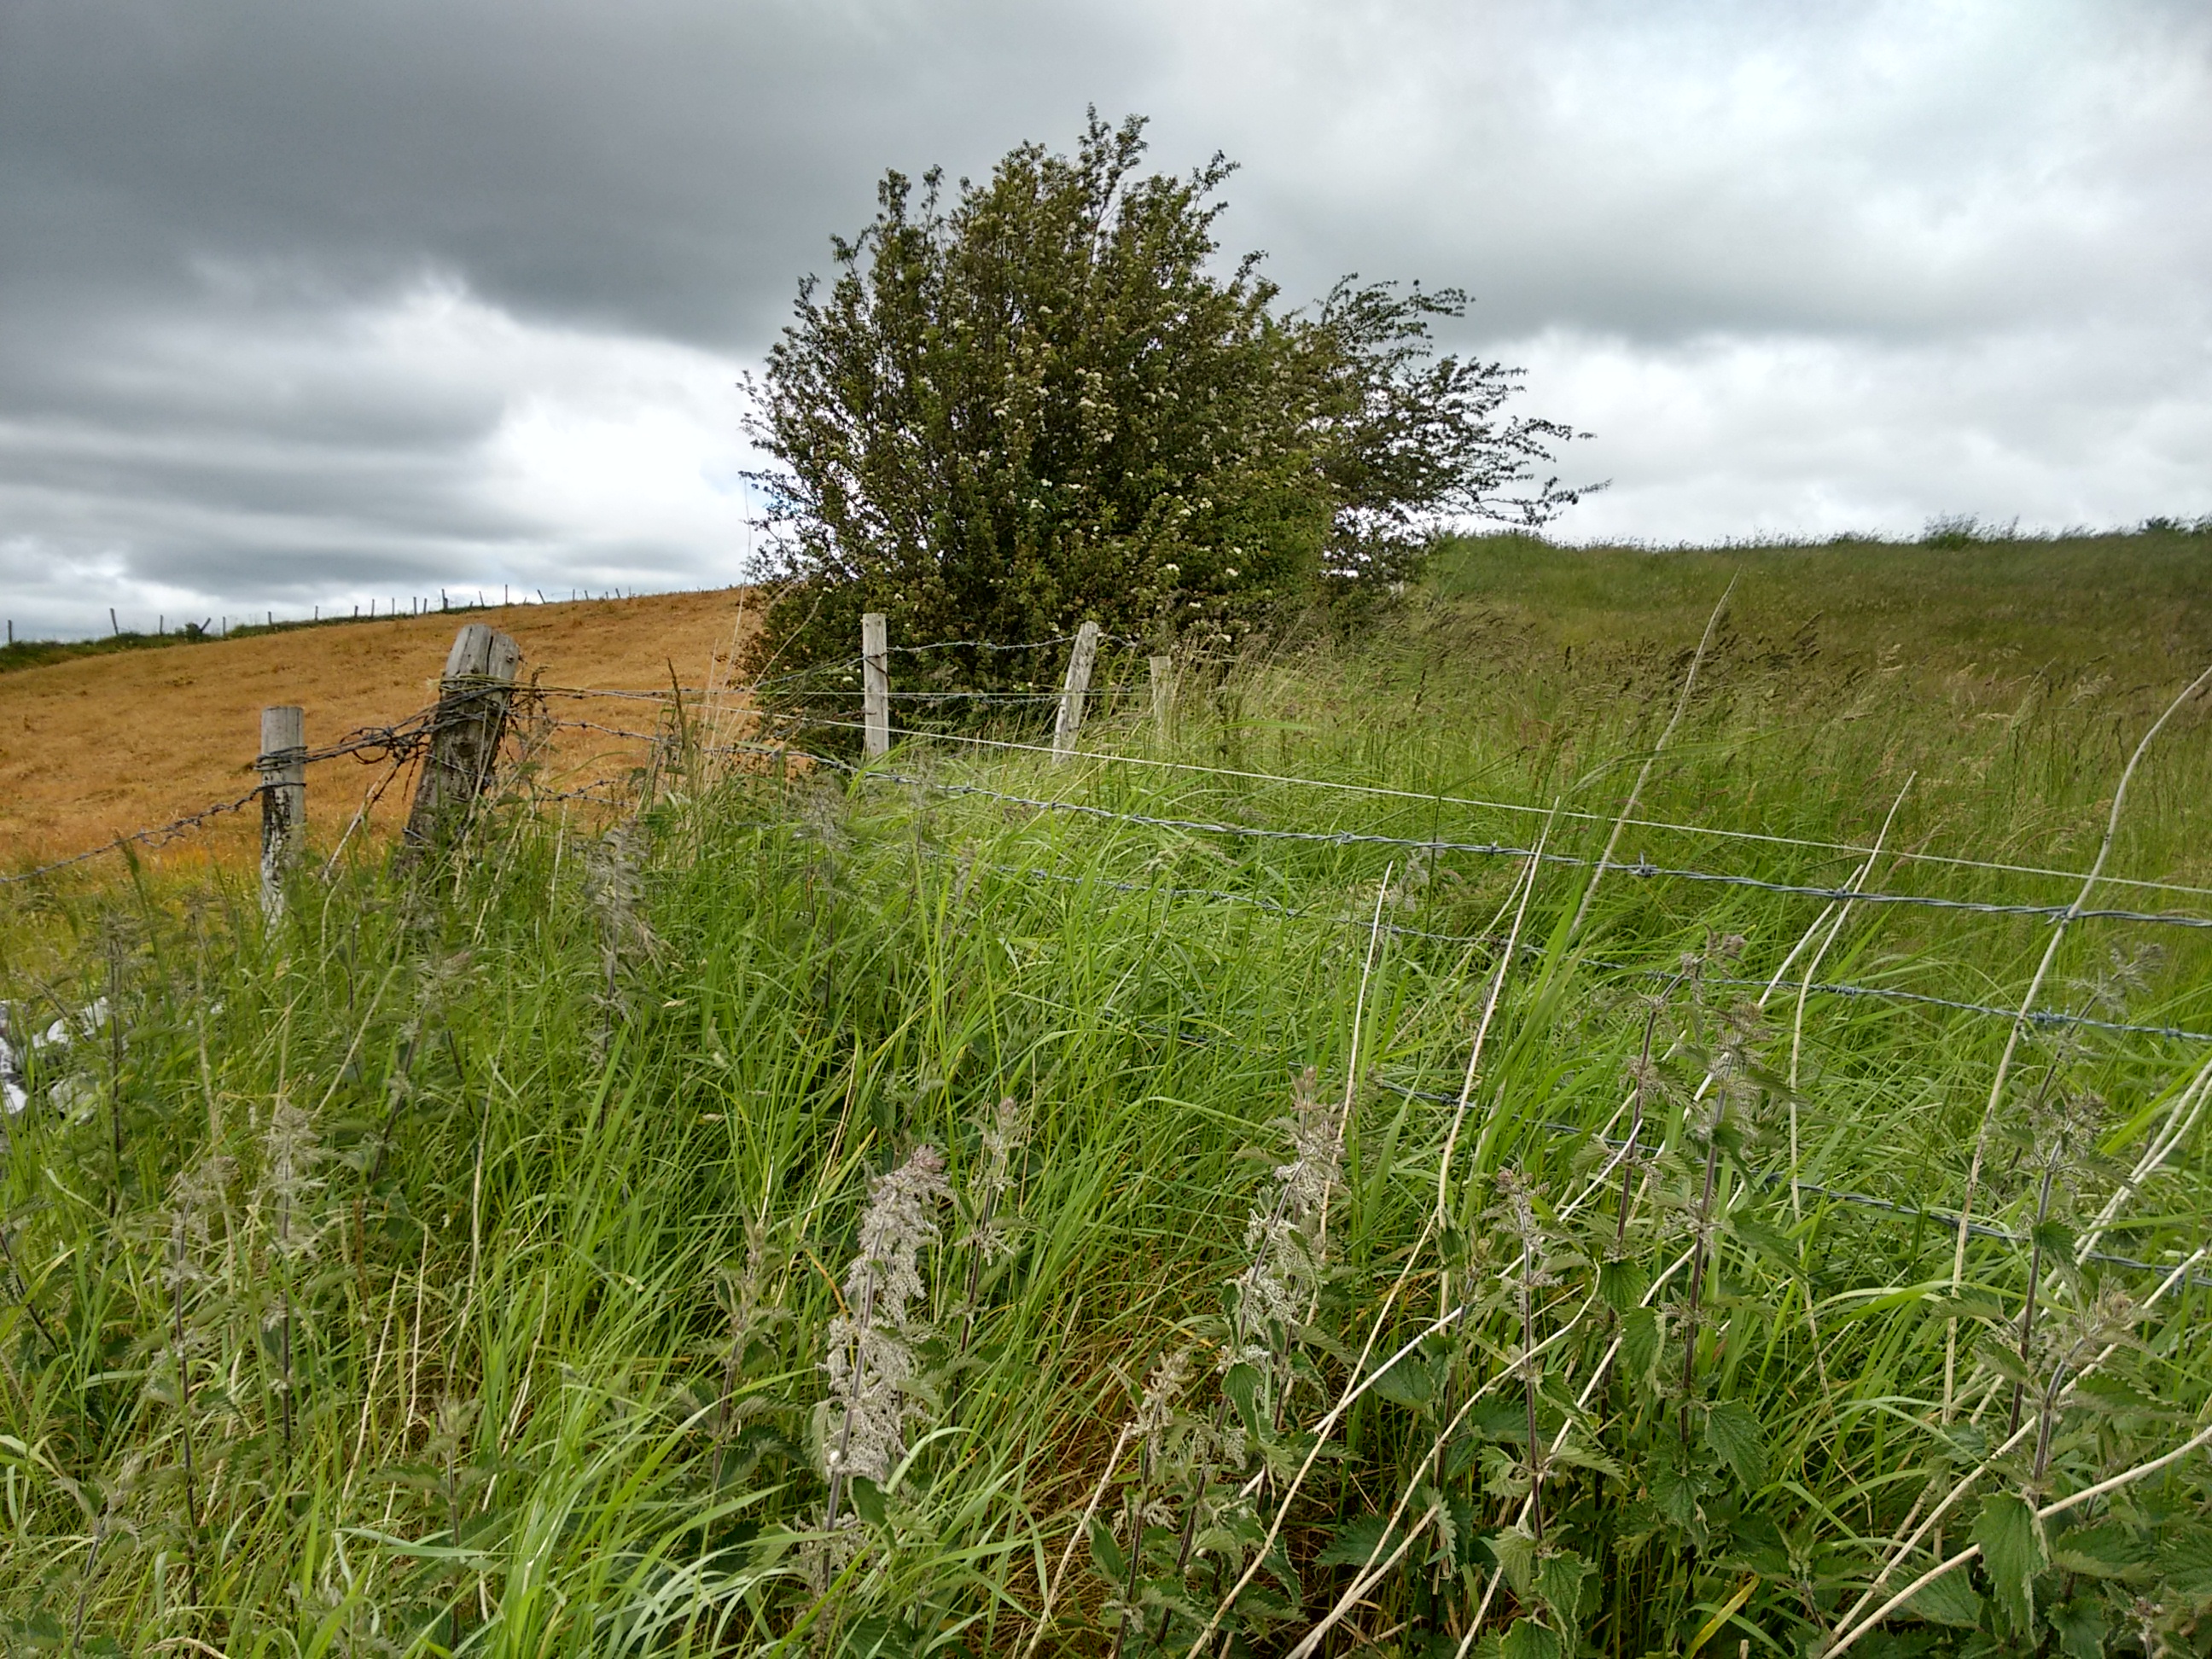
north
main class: Grassland
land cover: Grassland without tree/shrub cover
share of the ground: > 75 %
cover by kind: herbaceous plants 100 %
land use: Agriculture (excluding fallow land and kitchen gardens)
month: June
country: IE
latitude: 53.6049
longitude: -8.8401
